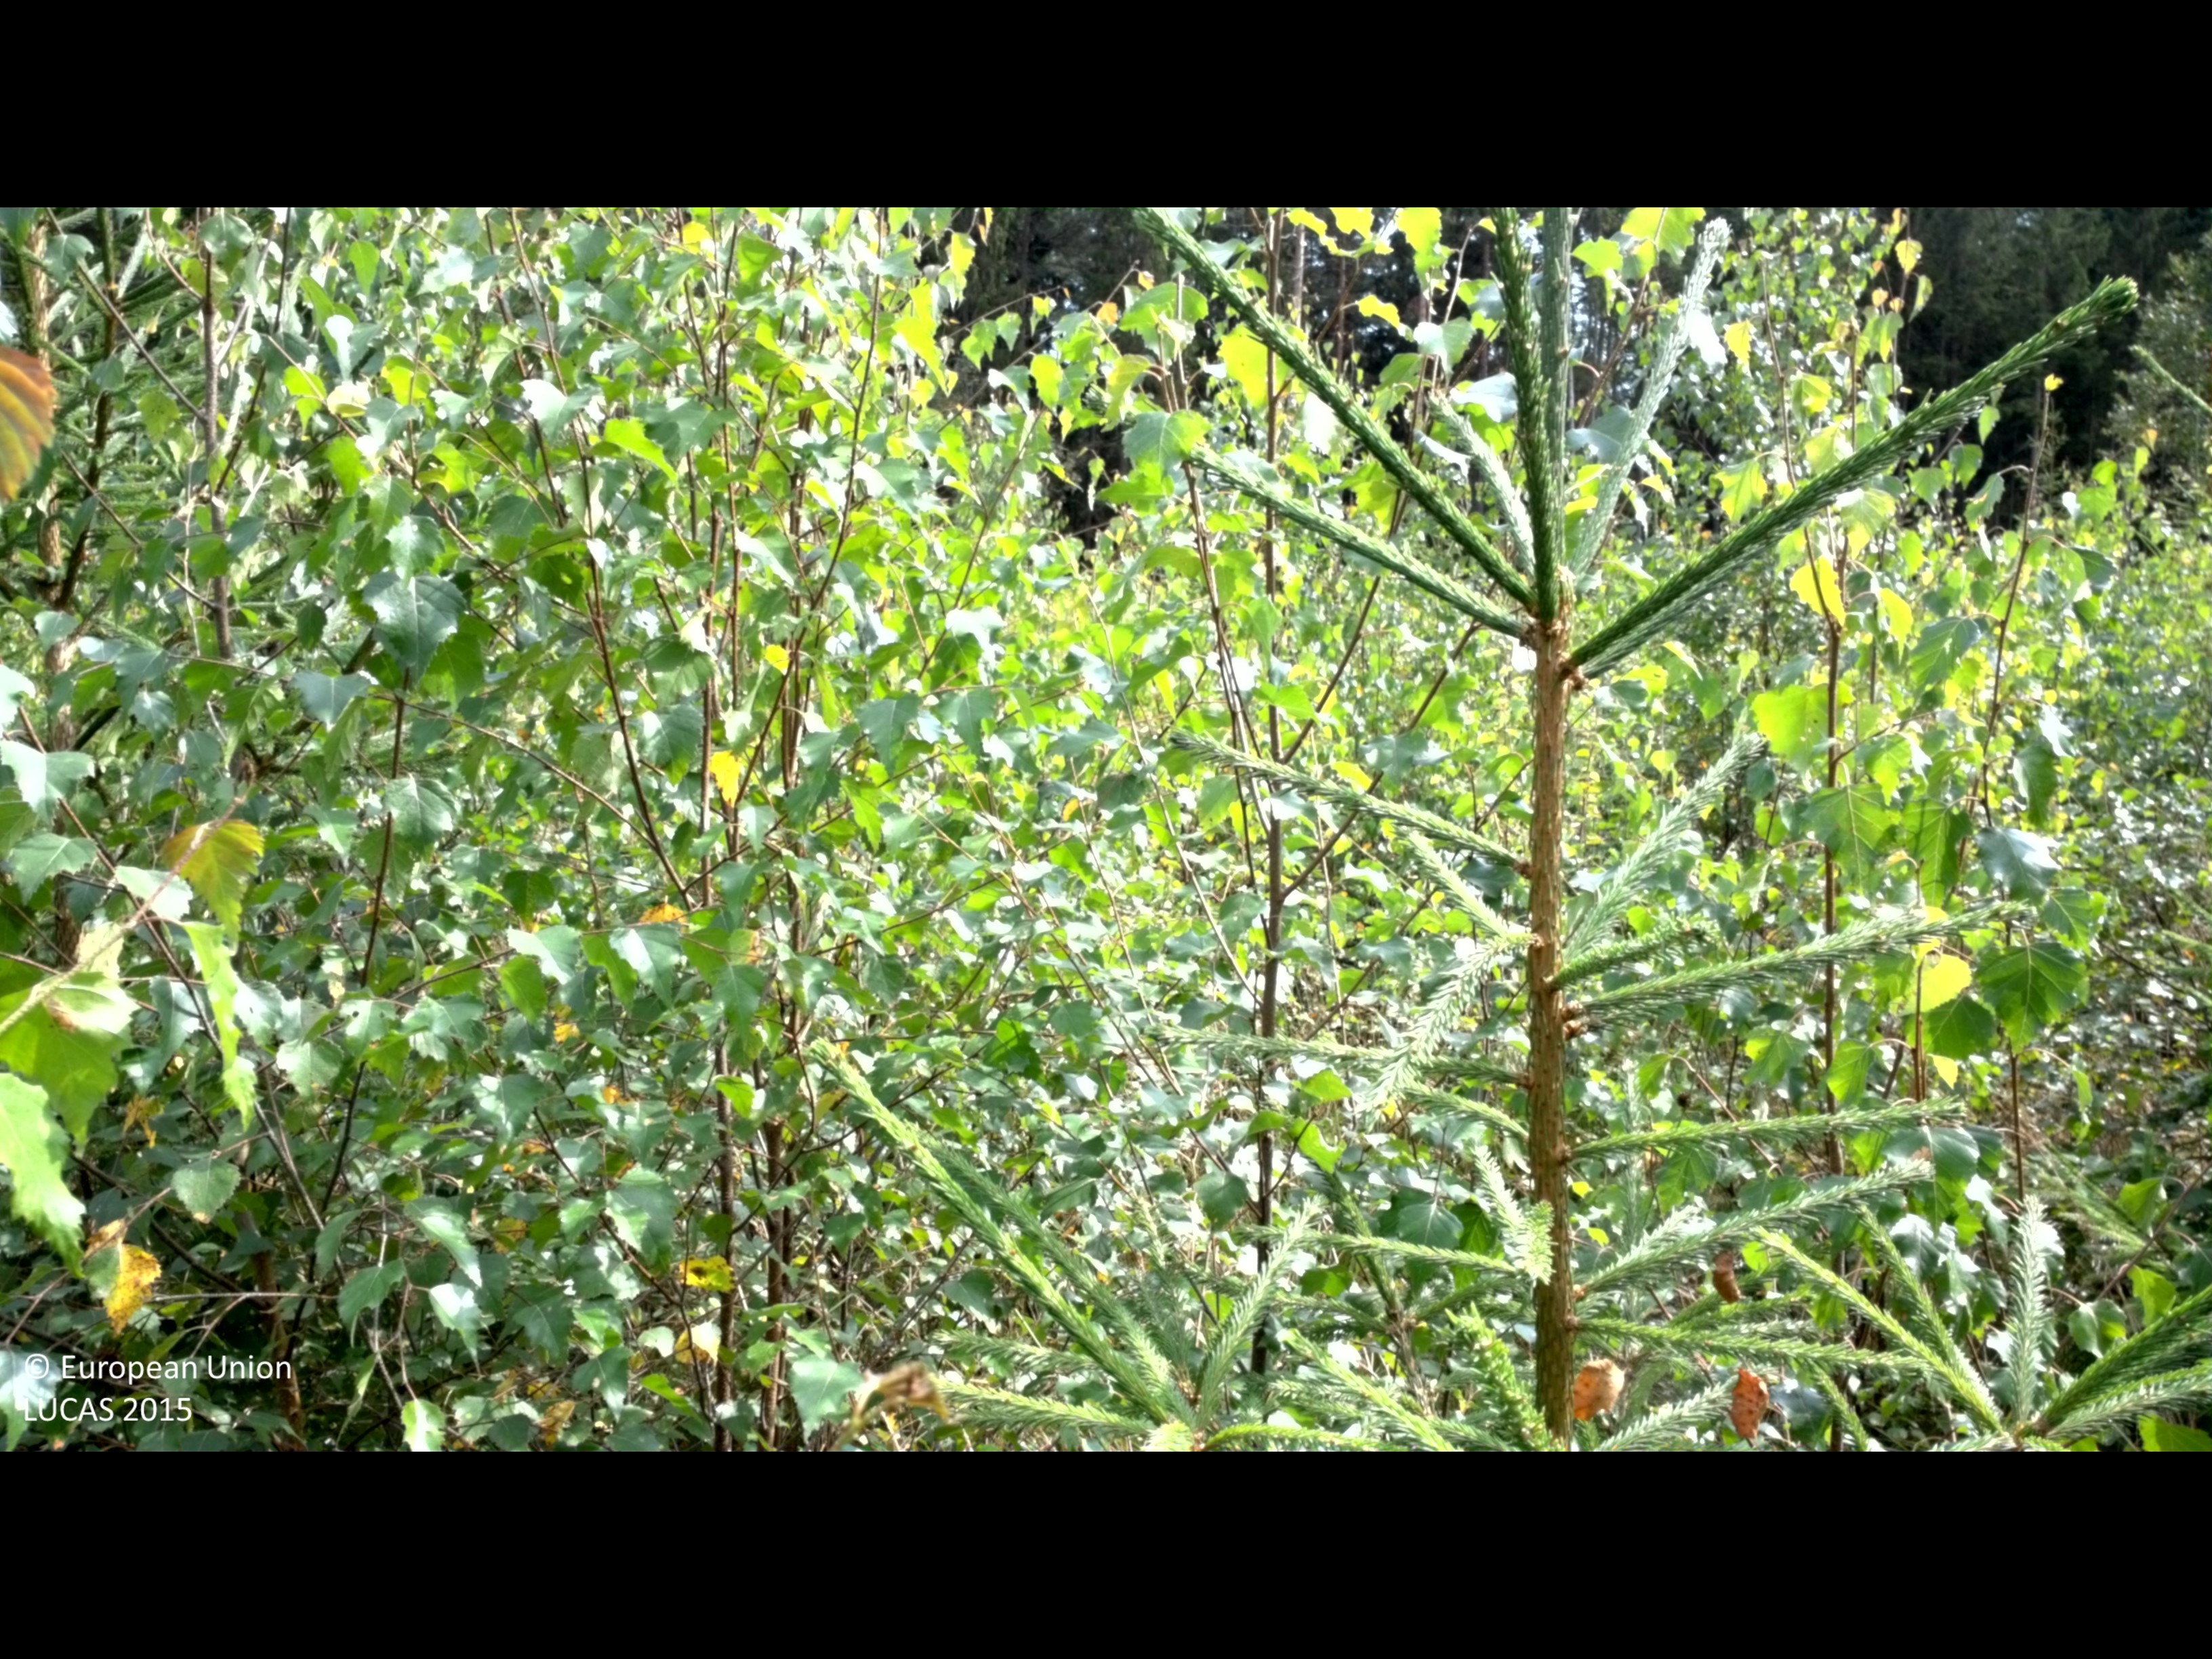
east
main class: Woodland
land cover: Spruce dominated mixed woodland
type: boreal forest
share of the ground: > 75 %
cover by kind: broadleaved forest trees 45 %, coniferous forest trees 30 %, herbaceous plants 20 %, shrubs 5 %
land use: Forestry
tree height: < 5 m
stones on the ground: < 10 %
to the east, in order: Spruce dominated mixed woodland; Pine dominated coniferous woodland; Spruce dominated coniferous woodland; Ditches and canals; Spruce dominated coniferous woodland; Paved roads, cycling and walking lanes; Spruce dominated coniferous woodland
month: August
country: SE
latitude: 56.8520
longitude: 13.7844
